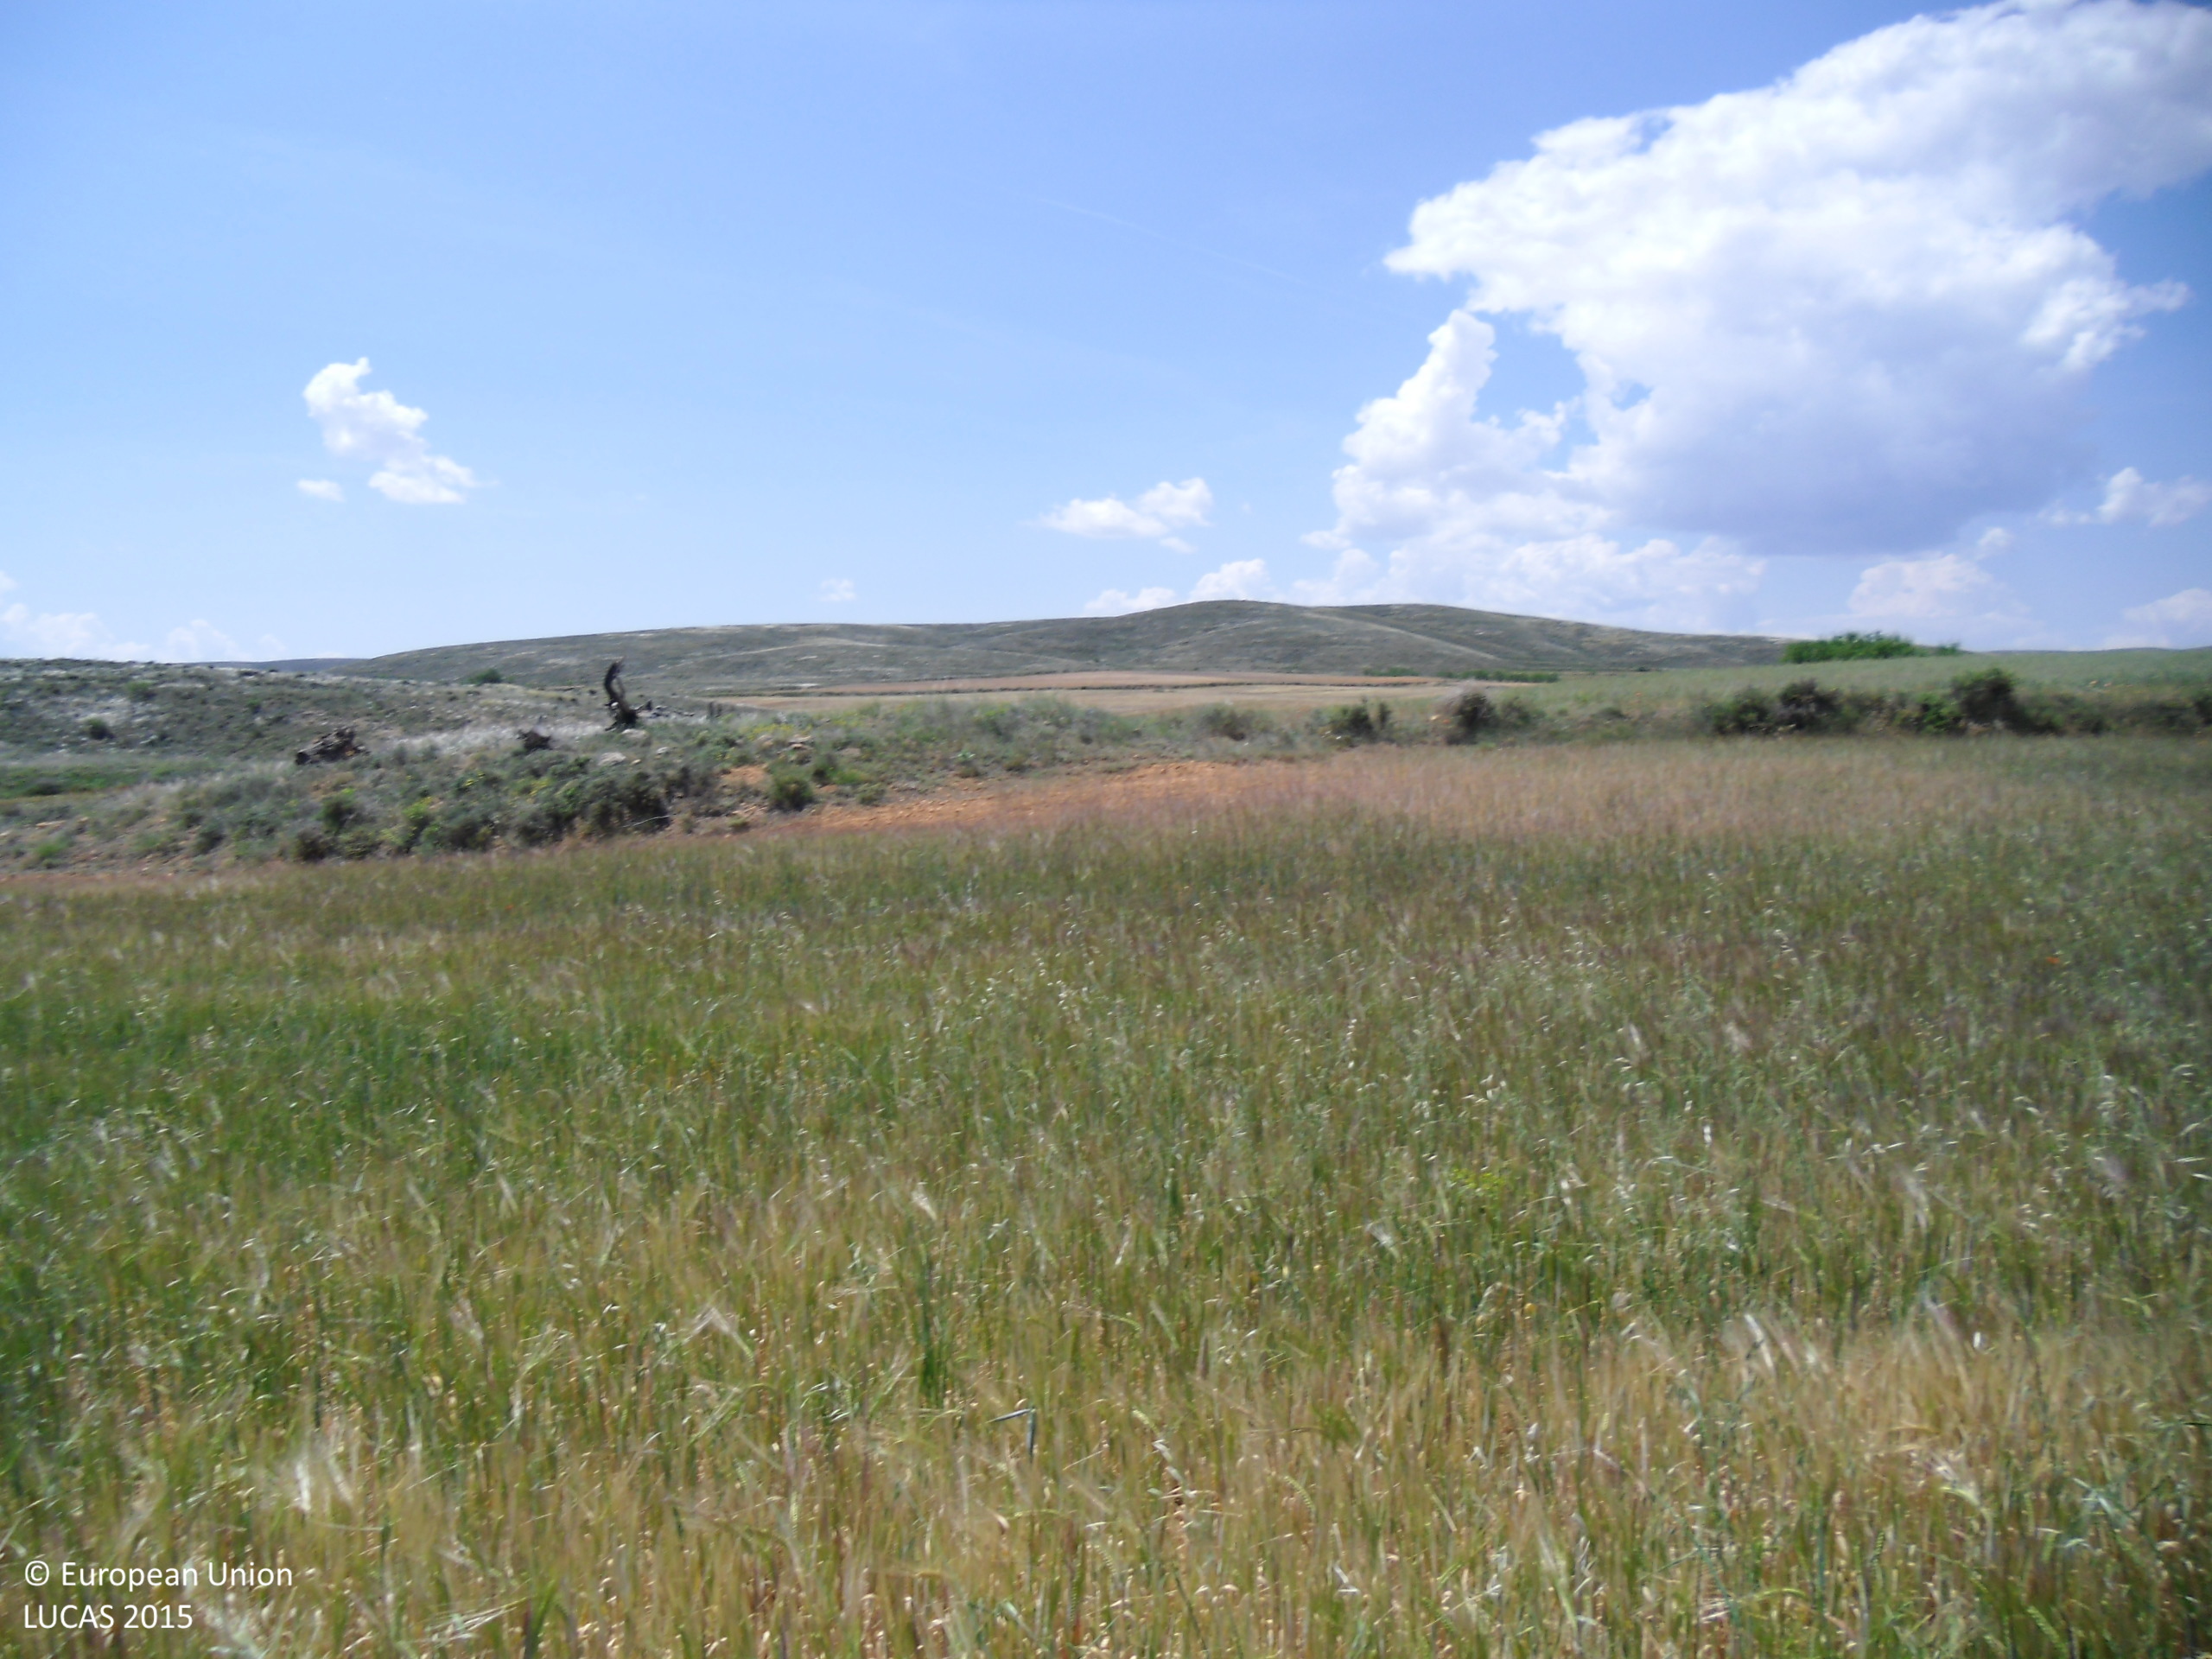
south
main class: Cropland
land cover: Barley
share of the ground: > 75 %
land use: Agriculture (excluding fallow land and kitchen gardens)
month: June
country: ES
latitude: 41.0847
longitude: -0.8606
